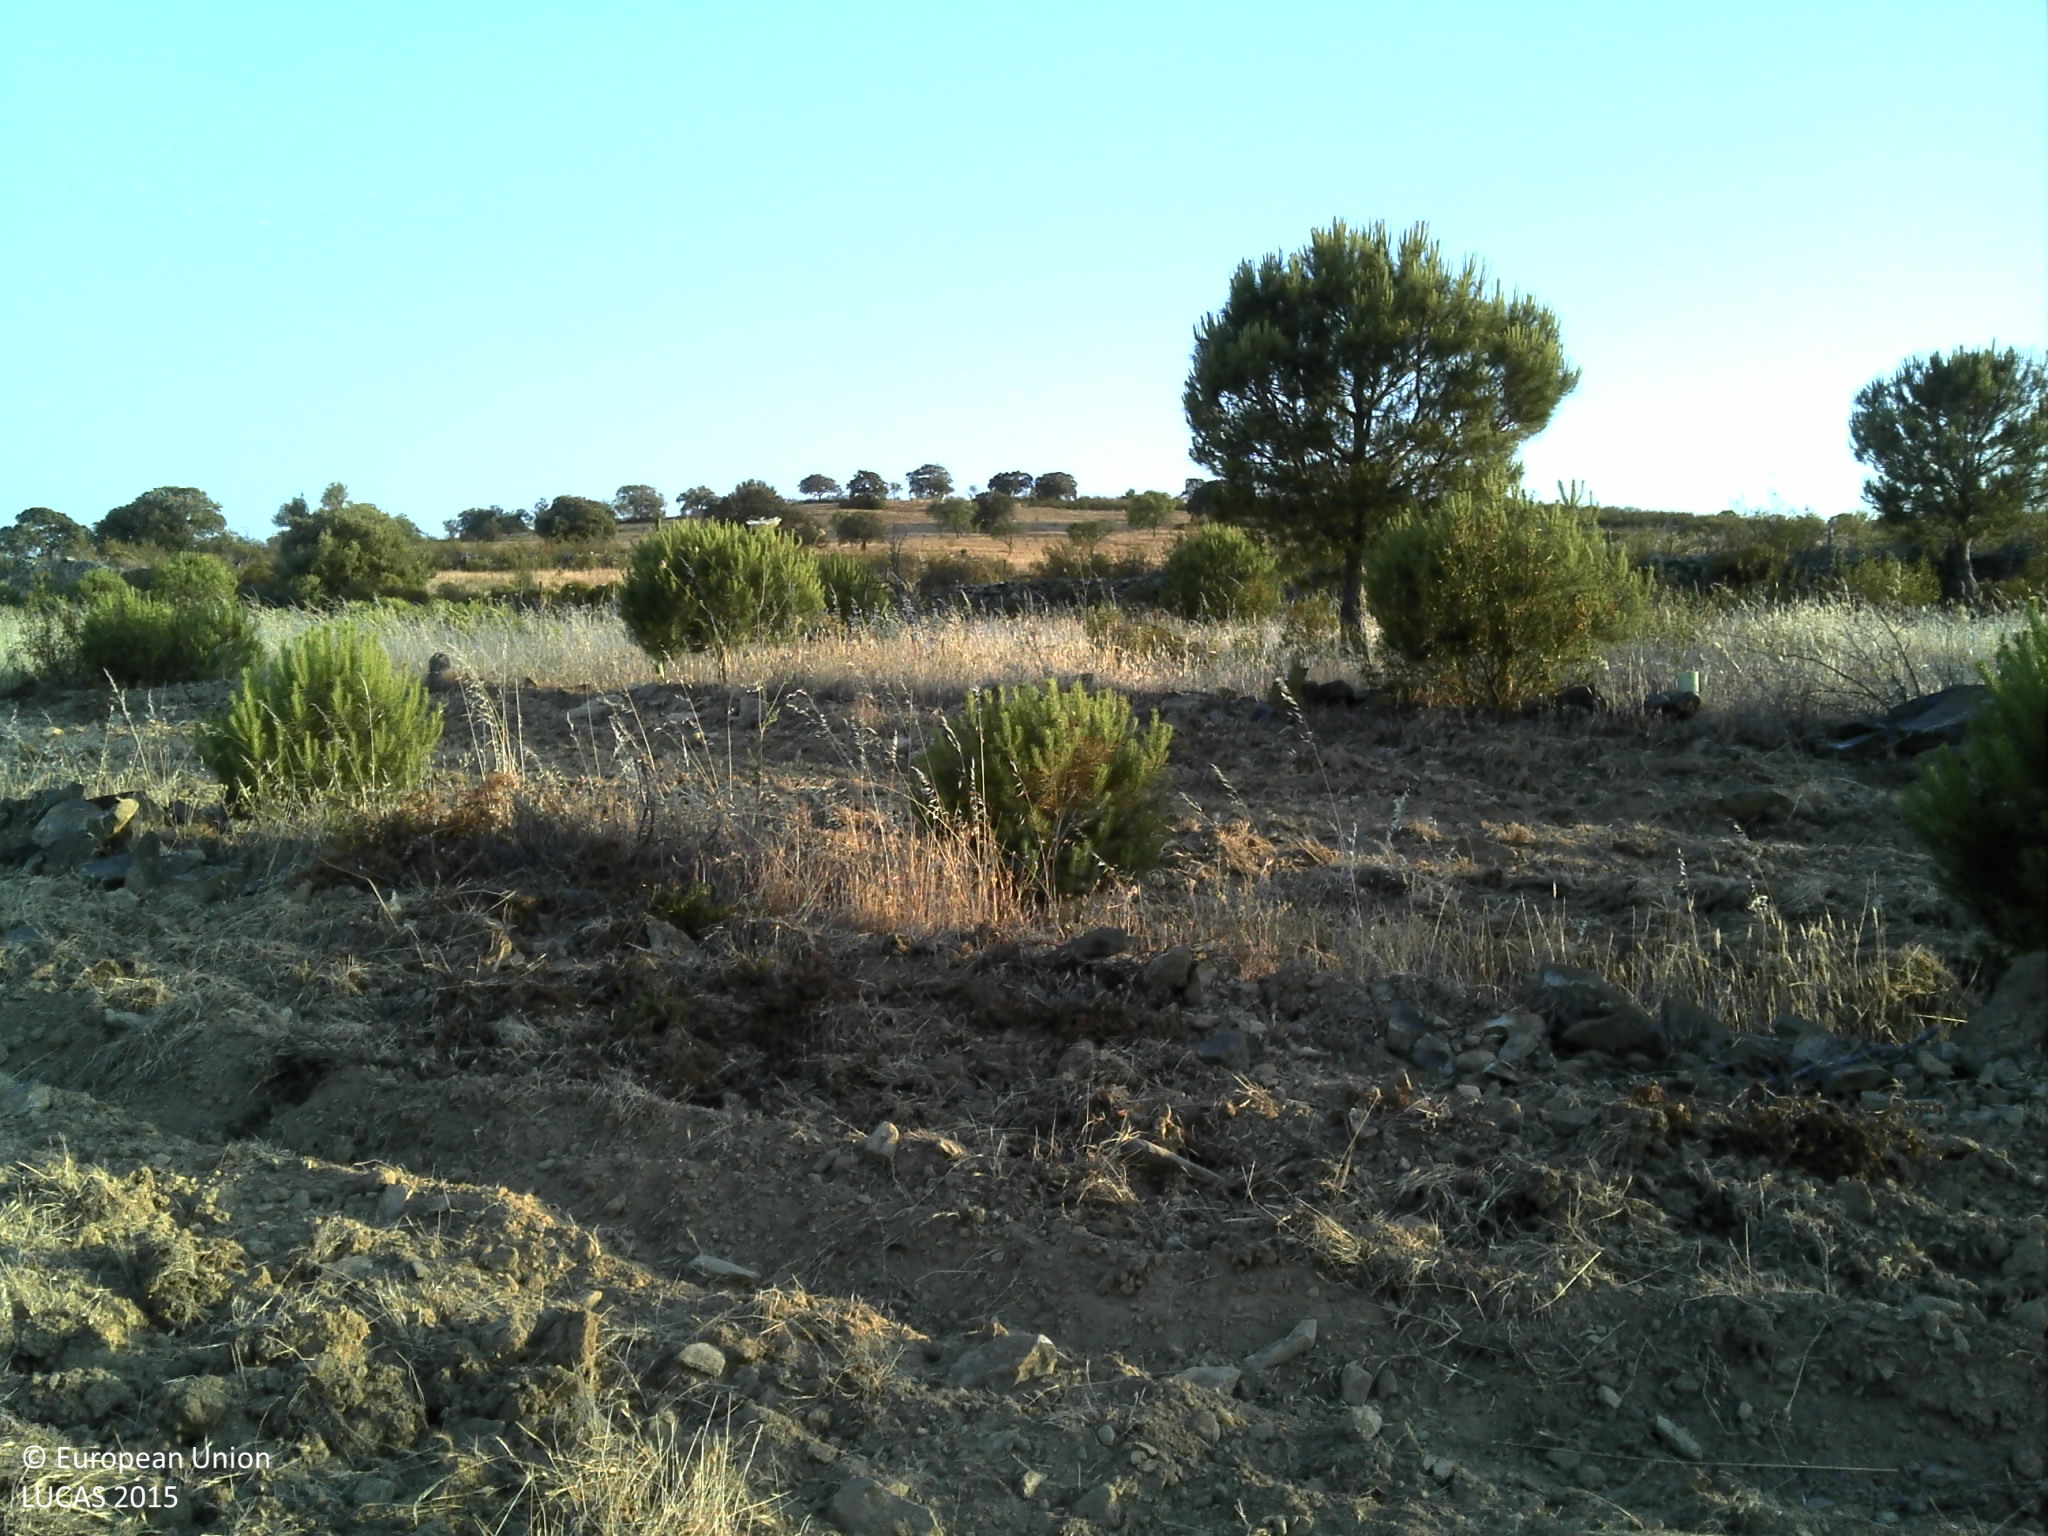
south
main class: Woodland
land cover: Pine dominated coniferous woodland
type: coniferous forest of the mediterranean region
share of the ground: 10 - 25 %
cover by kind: consolidated bare surface 50 %, coniferous forest trees 25 %, herbaceous plants 25 %
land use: Forestry
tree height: < 5 m
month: May
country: PT
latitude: 37.5039
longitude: -7.7638
